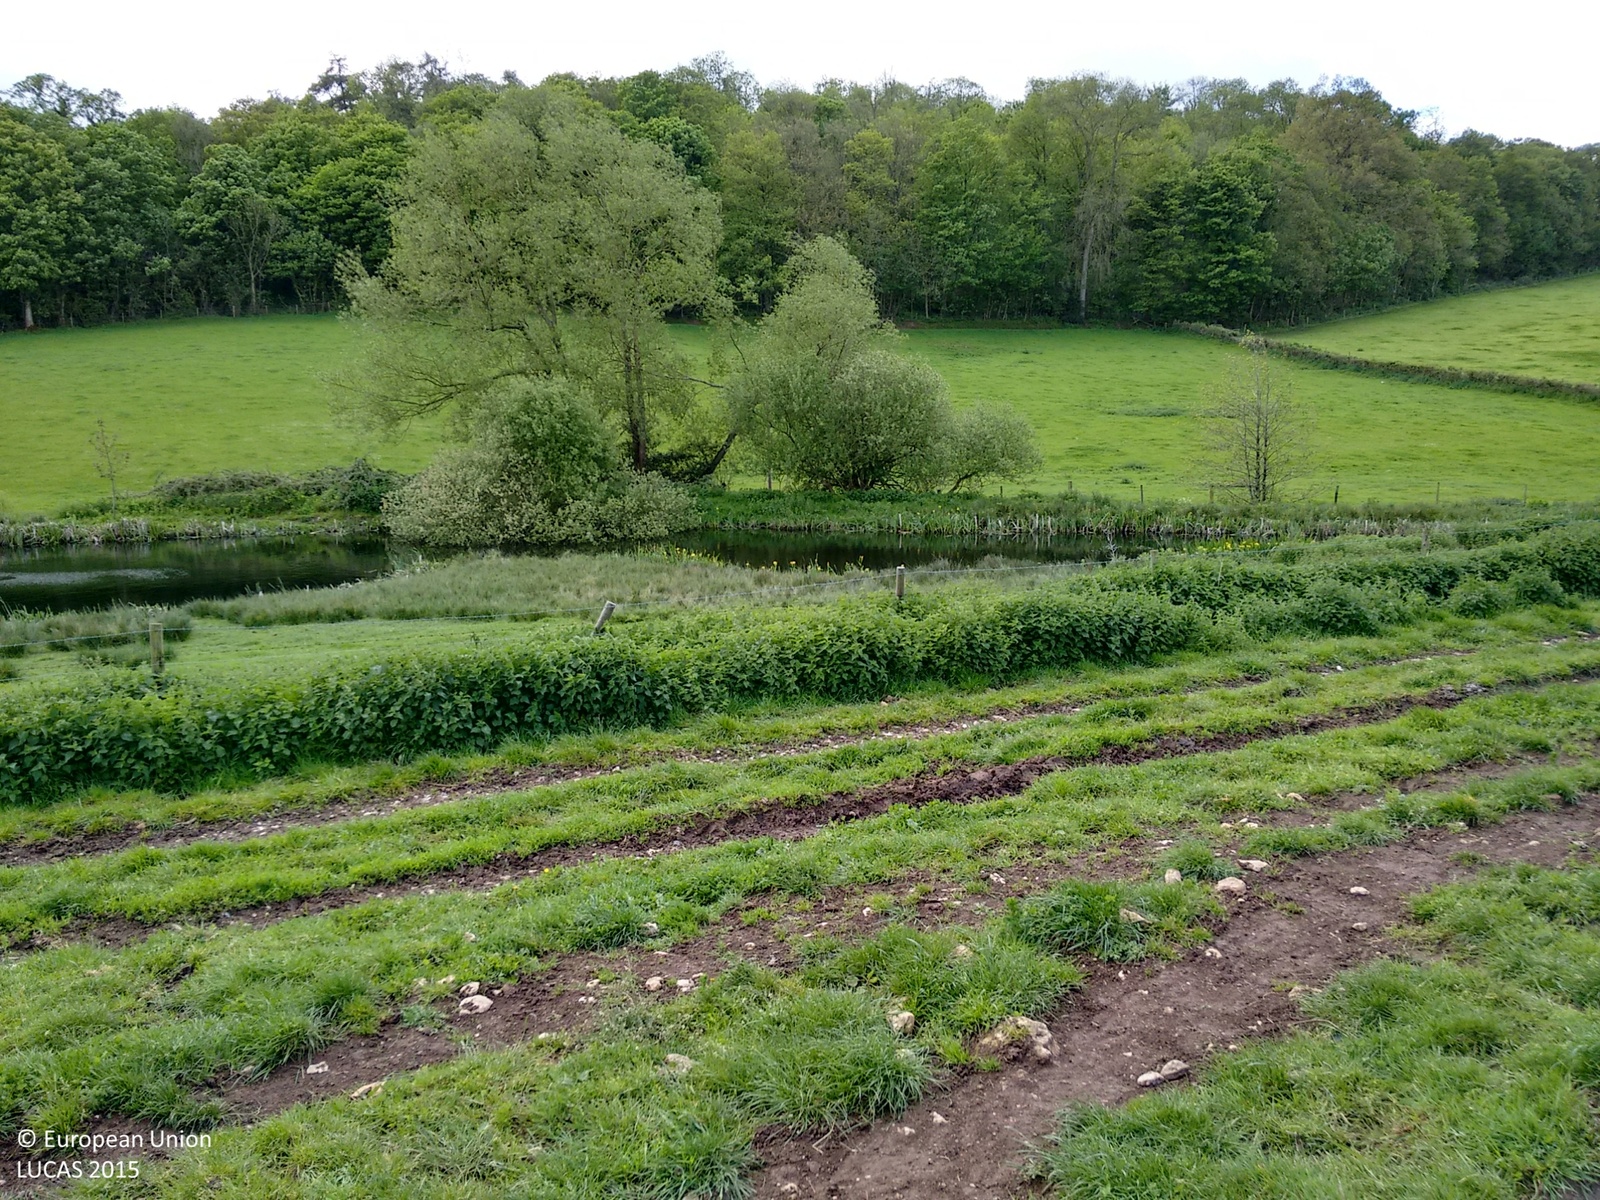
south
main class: Grassland
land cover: Grassland without tree/shrub cover
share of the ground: > 75 %
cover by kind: herbaceous plants 100 %
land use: Agriculture (excluding fallow land and kitchen gardens)
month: May
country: GB
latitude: 50.9529
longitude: -2.4646
